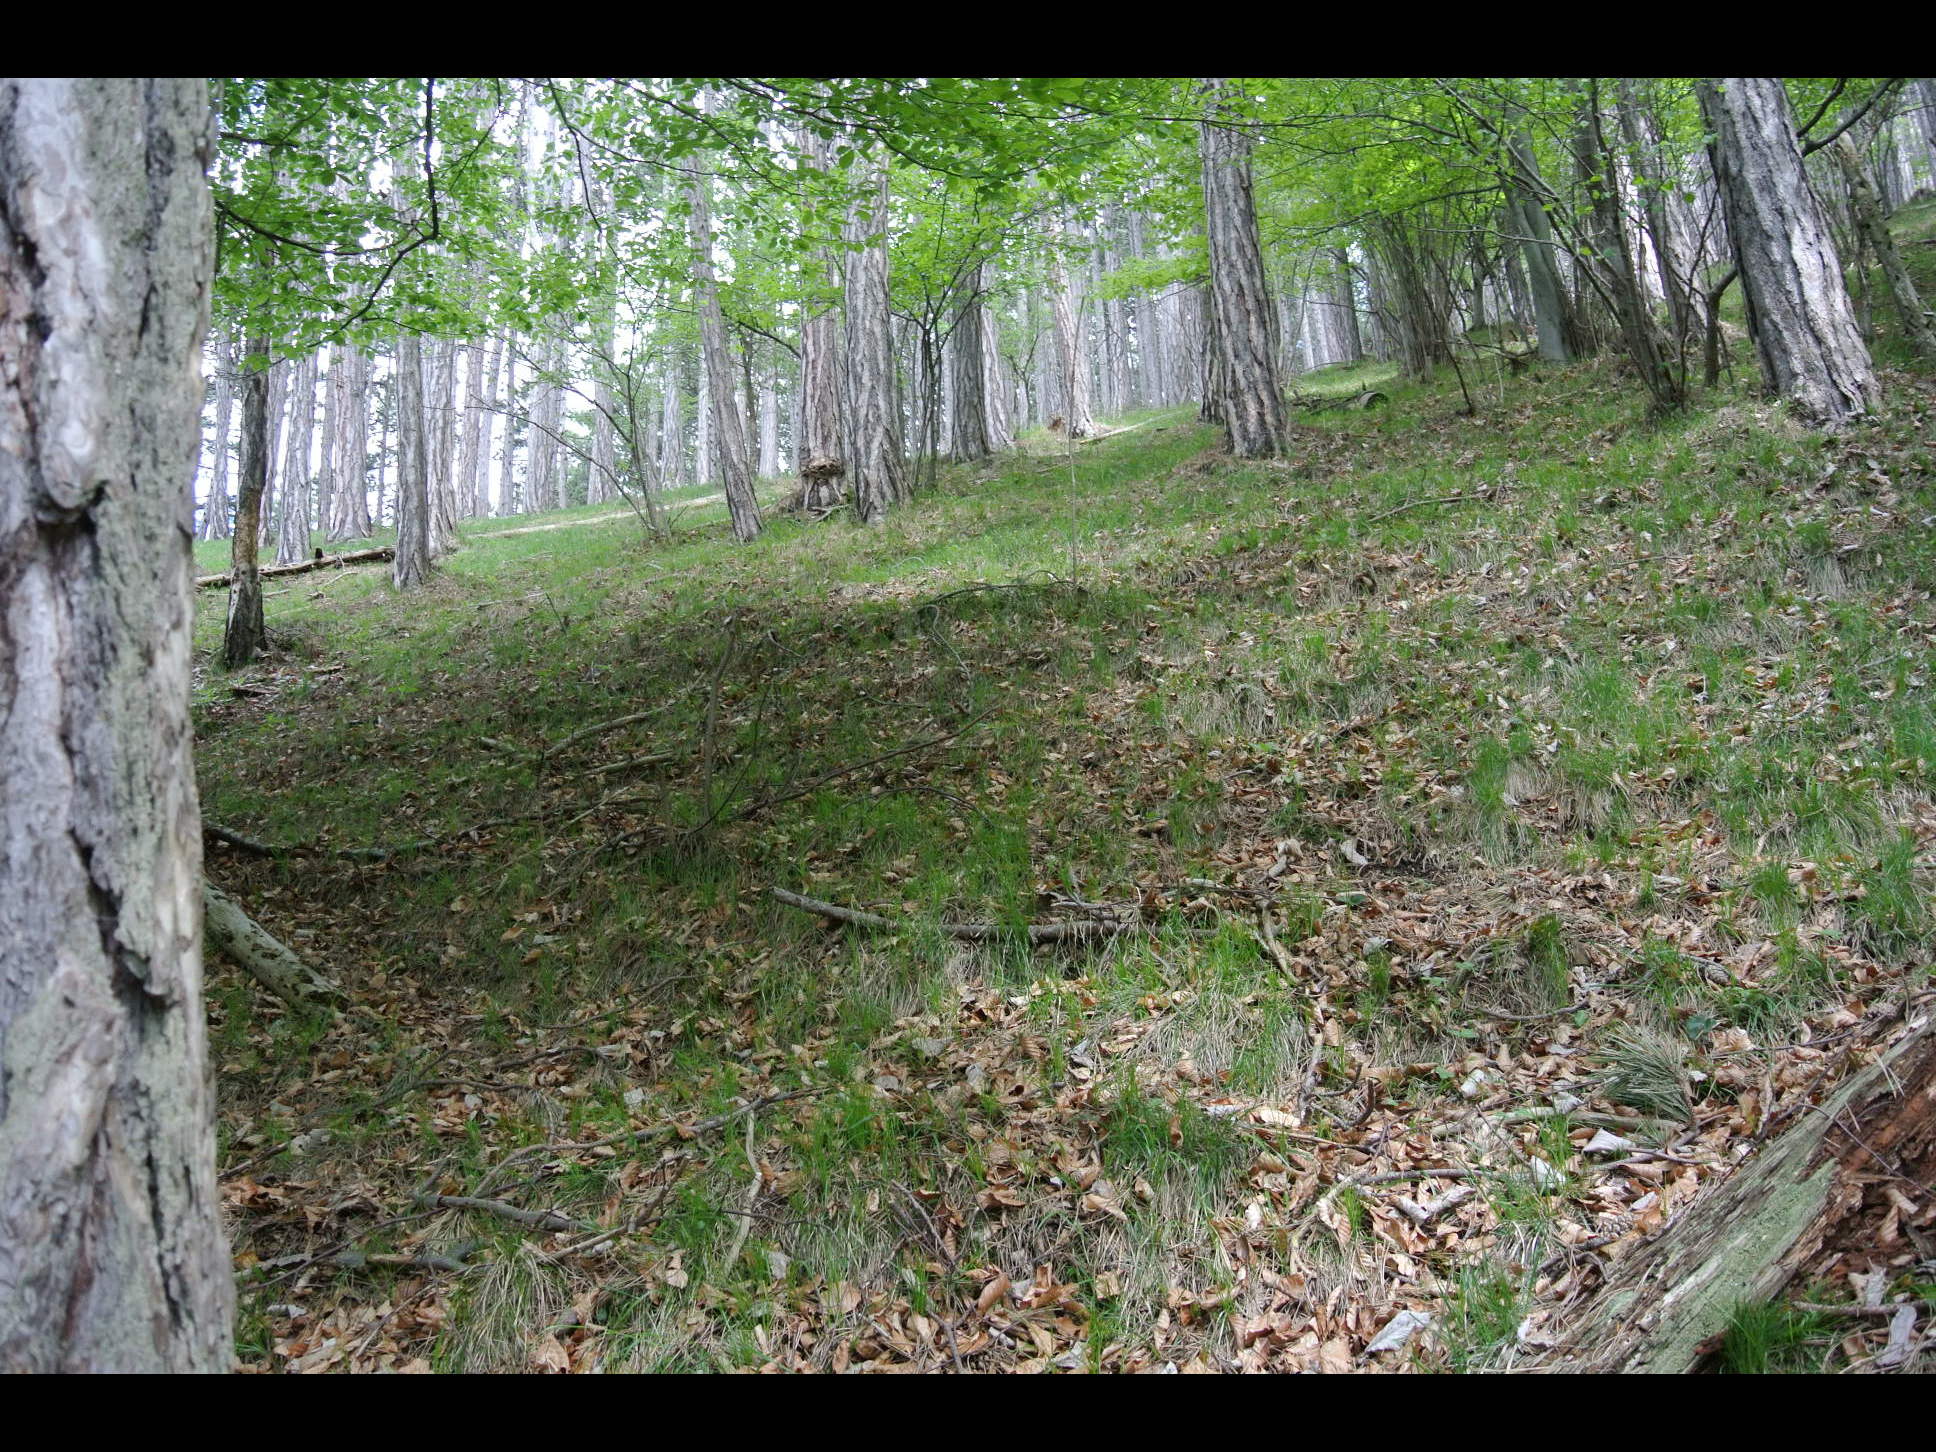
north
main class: Woodland
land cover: Pine dominated coniferous woodland
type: alpine coniferous forest
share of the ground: > 75 %
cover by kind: coniferous forest trees 95 %, broadleaved forest trees 5 %
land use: Forestry
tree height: > 5 m
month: May
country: AT
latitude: 47.8778
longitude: 16.0336
